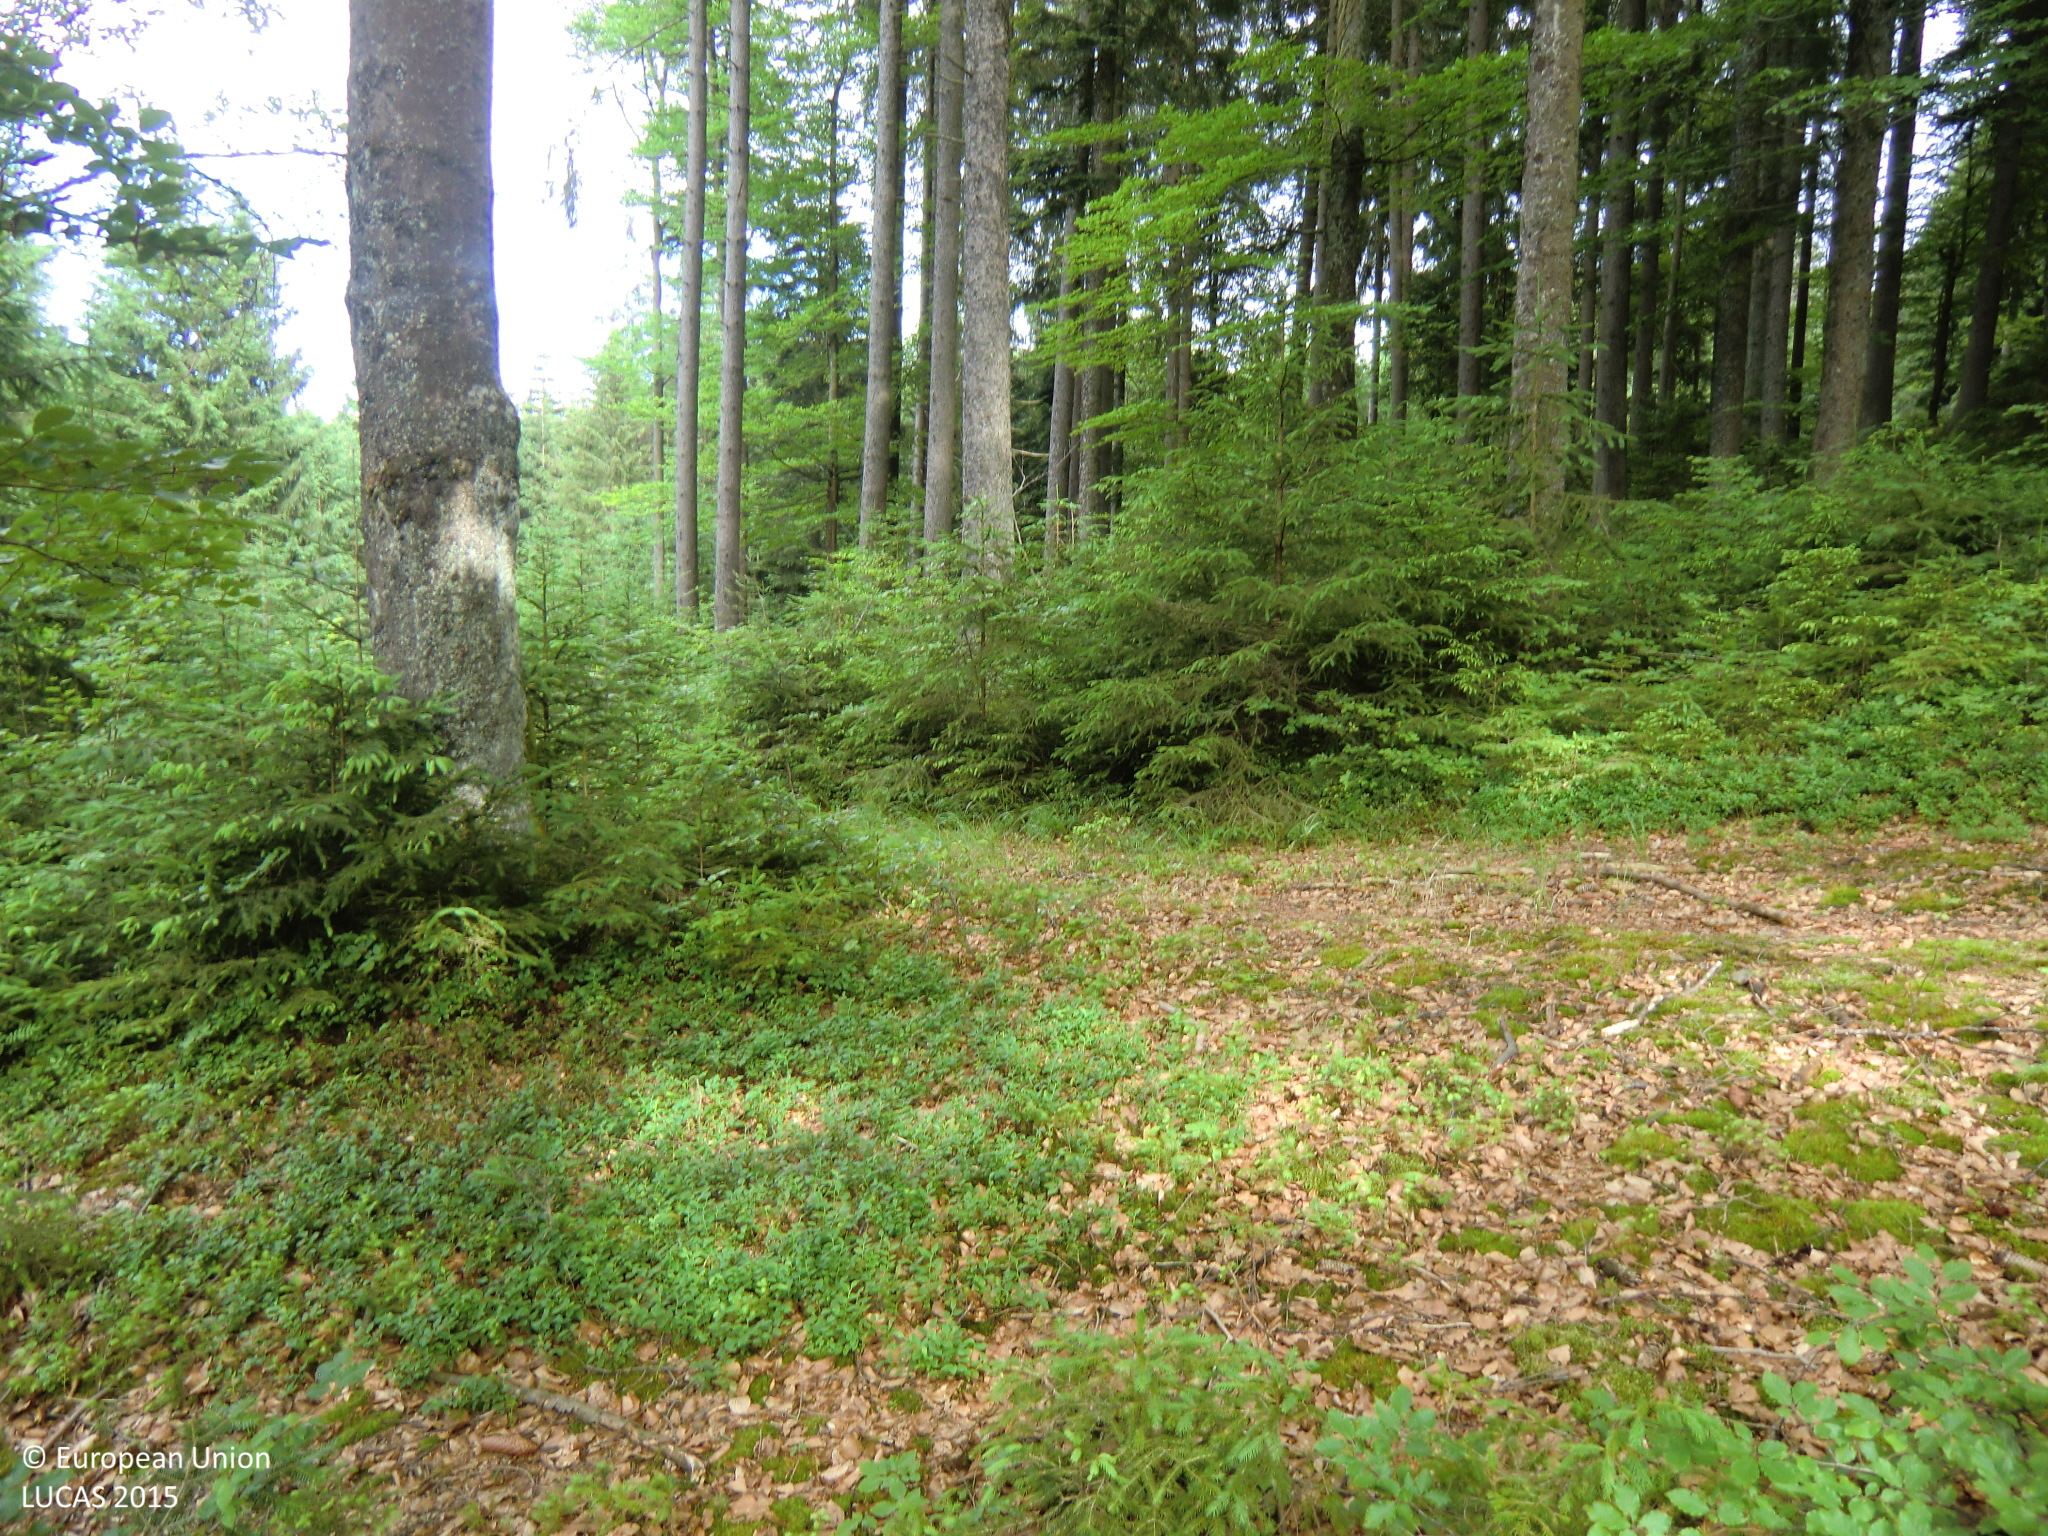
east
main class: Woodland
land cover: Spruce dominated mixed woodland
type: hemiboreal forest and nemoral coniferous forest and mixed broadleaved-coniferous forest
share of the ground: > 75 %
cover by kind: coniferous forest trees 45 %, broadleaved forest trees 45 %, herbaceous plants 5 %, unconsolidated bare surface 5 %
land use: Forestry
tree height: > 5 m
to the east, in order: Spruce dominated mixed woodland; Tracks; Spruce dominated coniferous woodland; Tracks; Spruce dominated coniferous woodland; Tracks; Spruce dominated coniferous woodland; Rivers and streams; Spruce dominated coniferous woodland
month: June
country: AT
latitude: 48.4531
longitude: 14.9909
